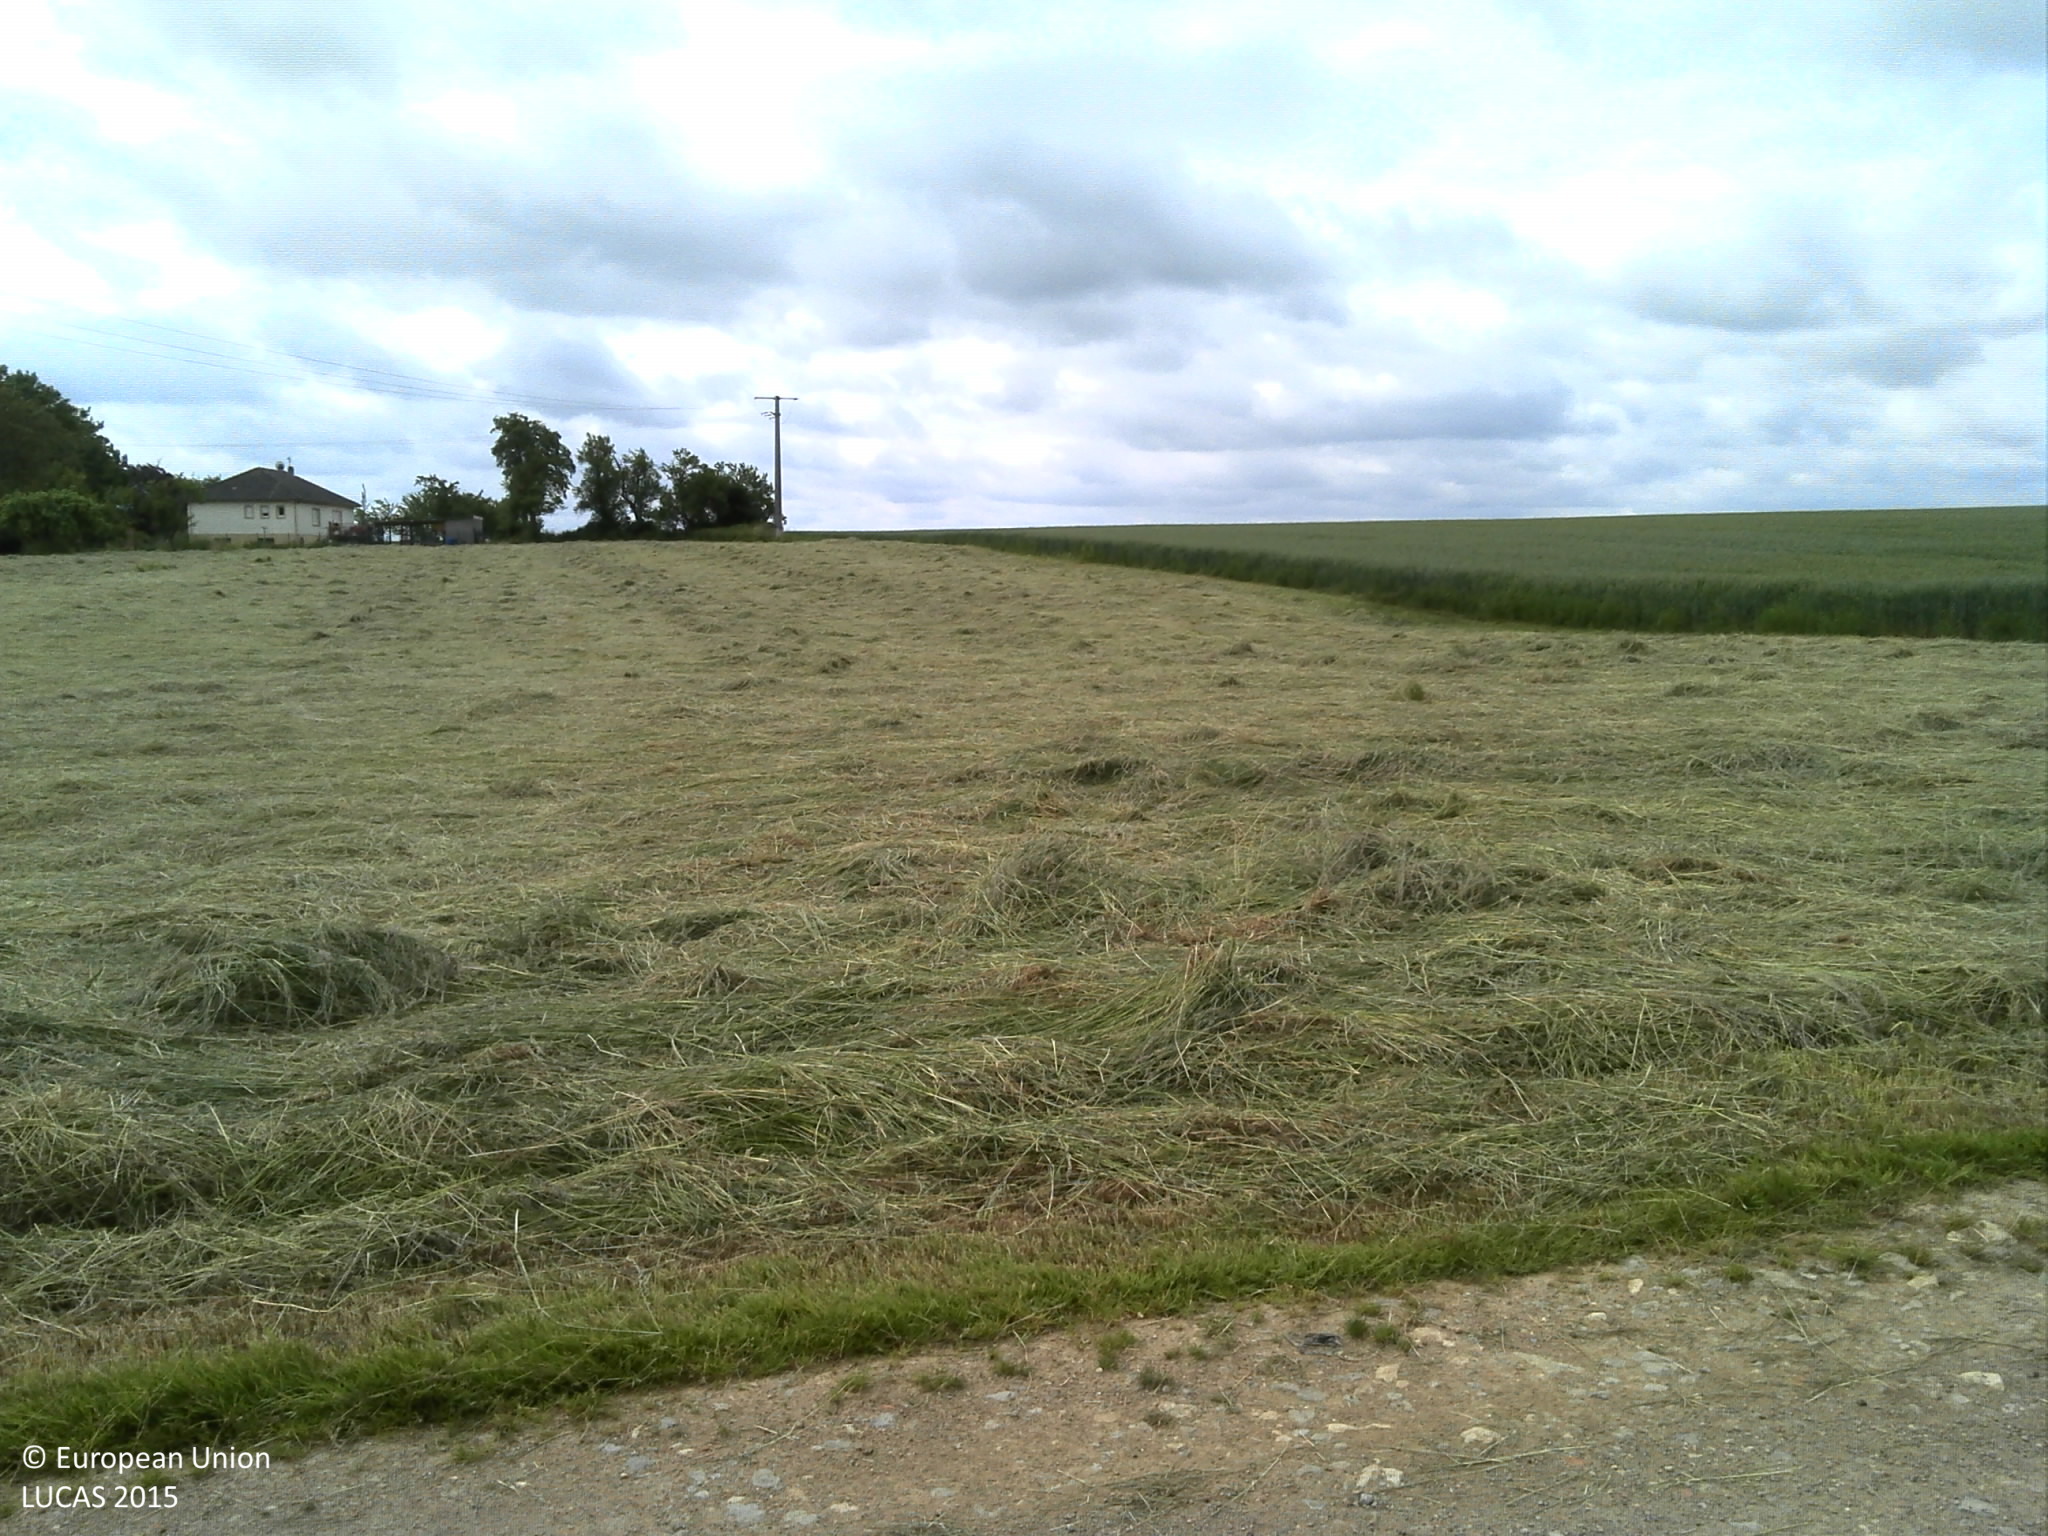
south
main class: Cropland
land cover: Rape and turnip rape
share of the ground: > 75 %
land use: Agriculture (excluding fallow land and kitchen gardens)
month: June
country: FR
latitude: 49.0032
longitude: 6.1586
